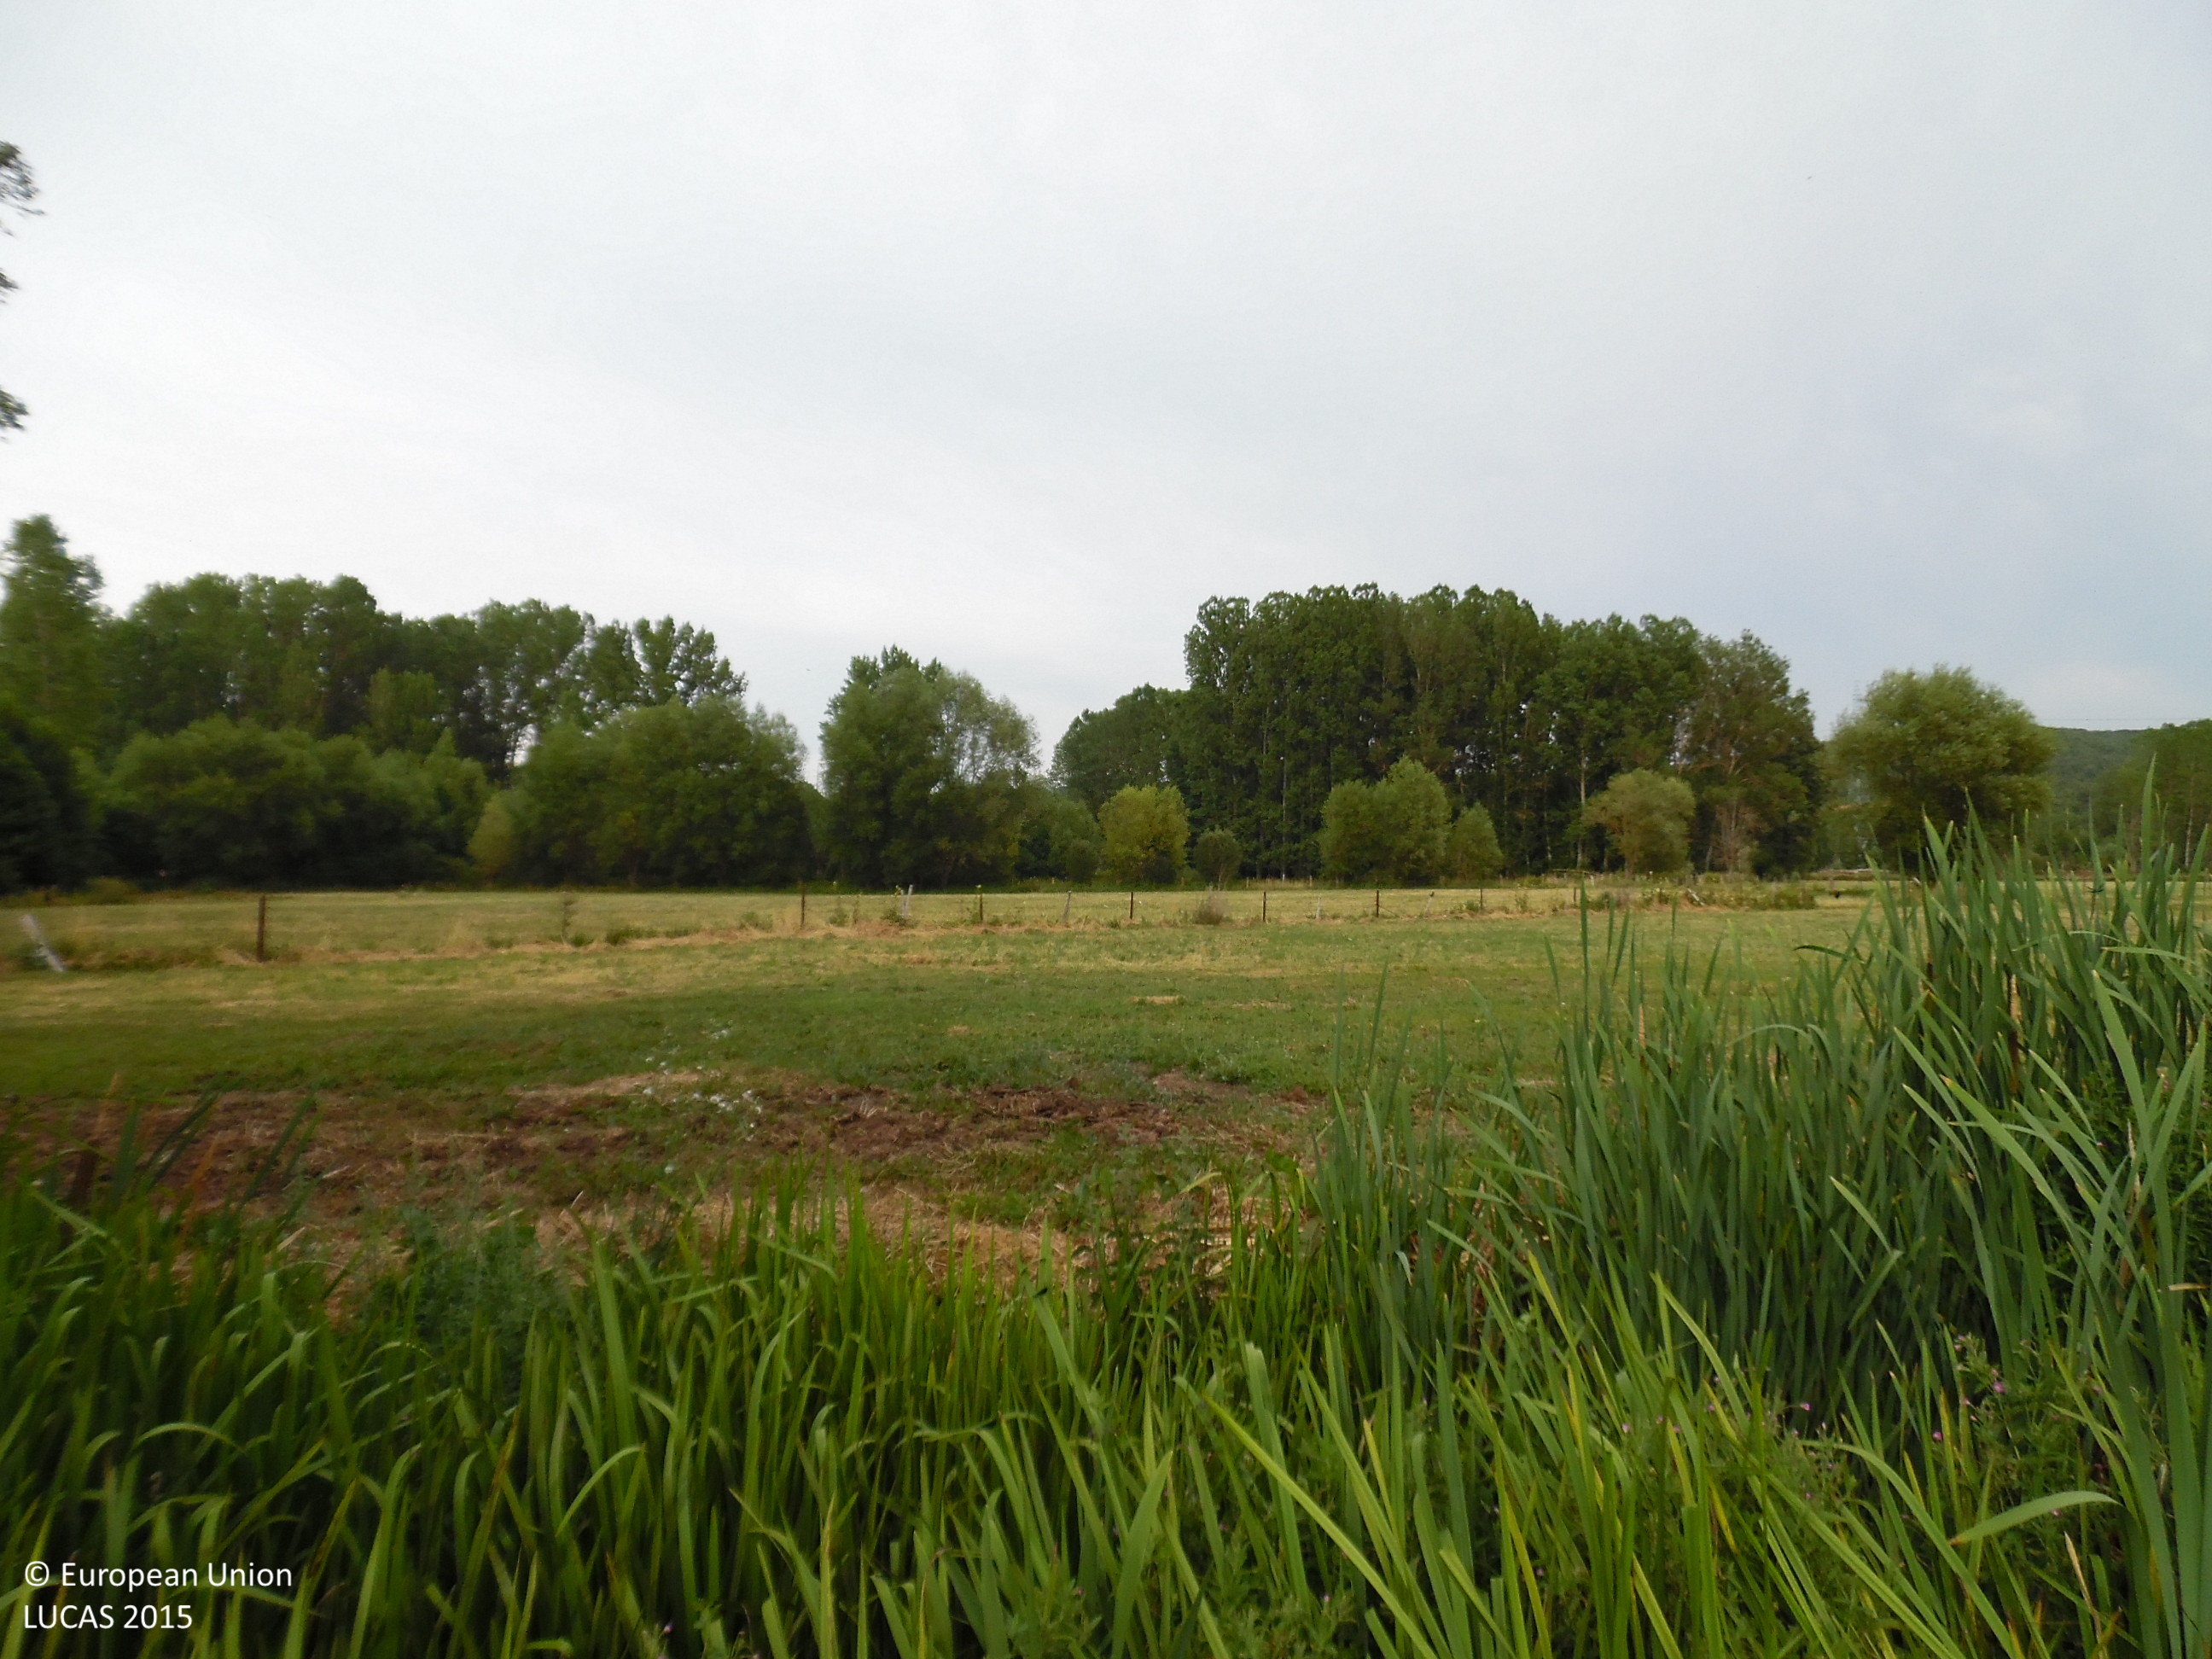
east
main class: Cropland
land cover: Temporary grasslands
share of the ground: > 75 %
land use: Agriculture (excluding fallow land and kitchen gardens)
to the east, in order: Temporary grasslands; Fences; Single bushes/trees; Ditches and canals; Grassland with sparse tree/shrub cover
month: July
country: ES
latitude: 42.7061
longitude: -5.8163
